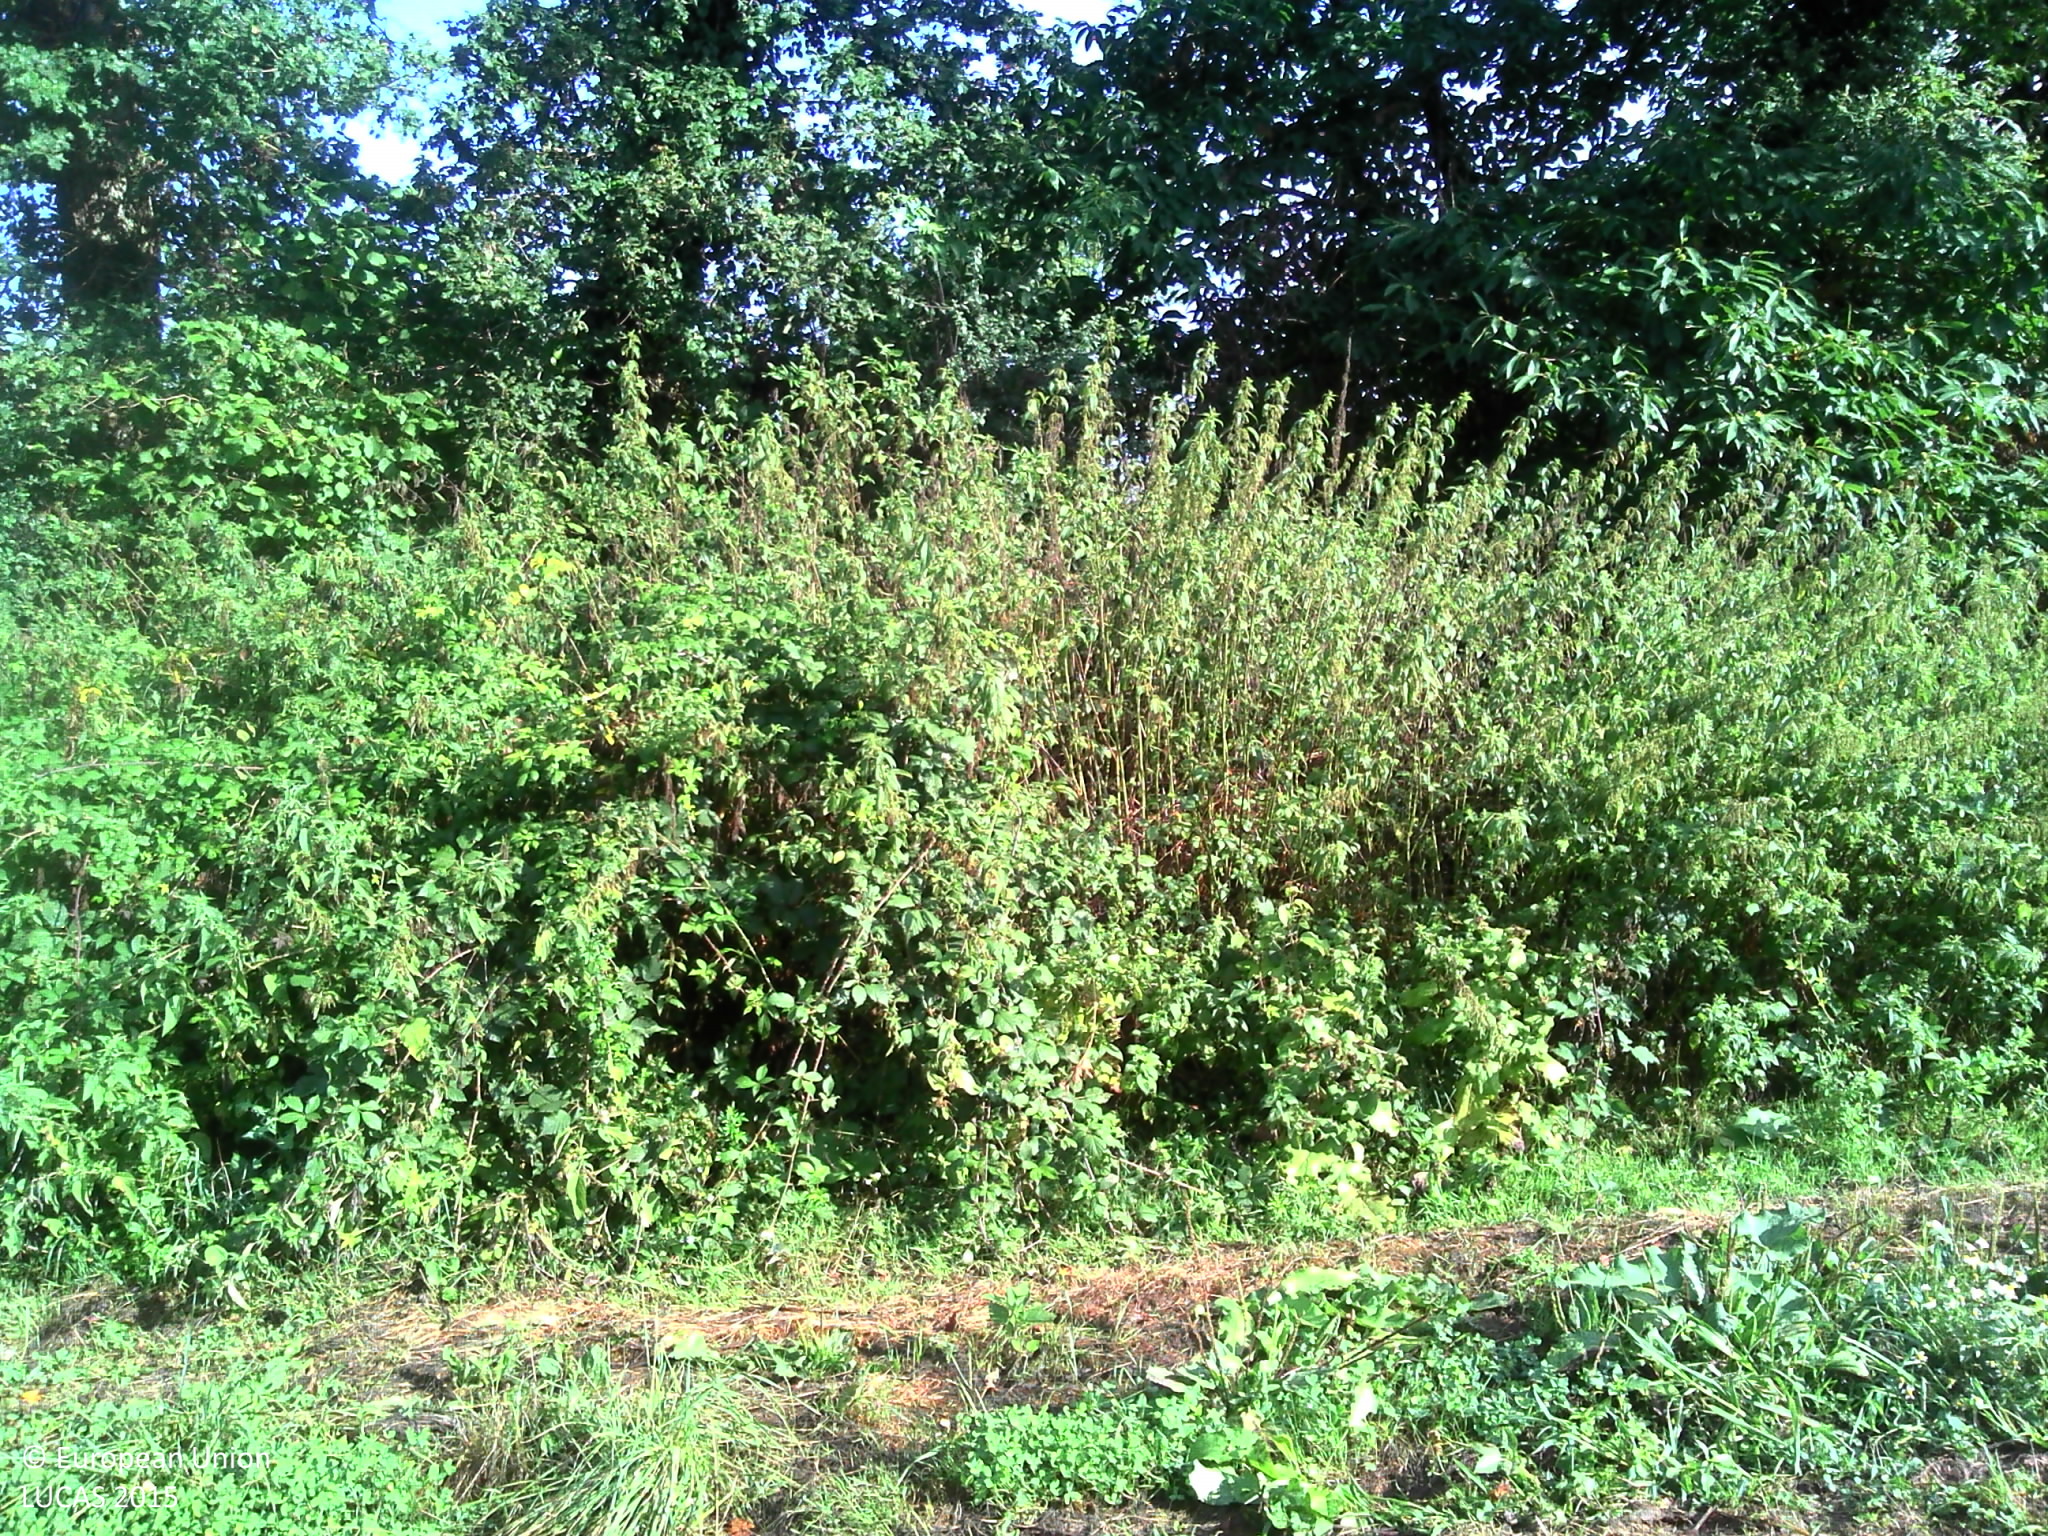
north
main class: Grassland
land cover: Grassland without tree/shrub cover
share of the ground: > 75 %
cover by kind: herbaceous plants 100 %
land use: Agriculture (excluding fallow land and kitchen gardens)
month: August
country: FR
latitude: 46.1893
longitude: 1.0087
